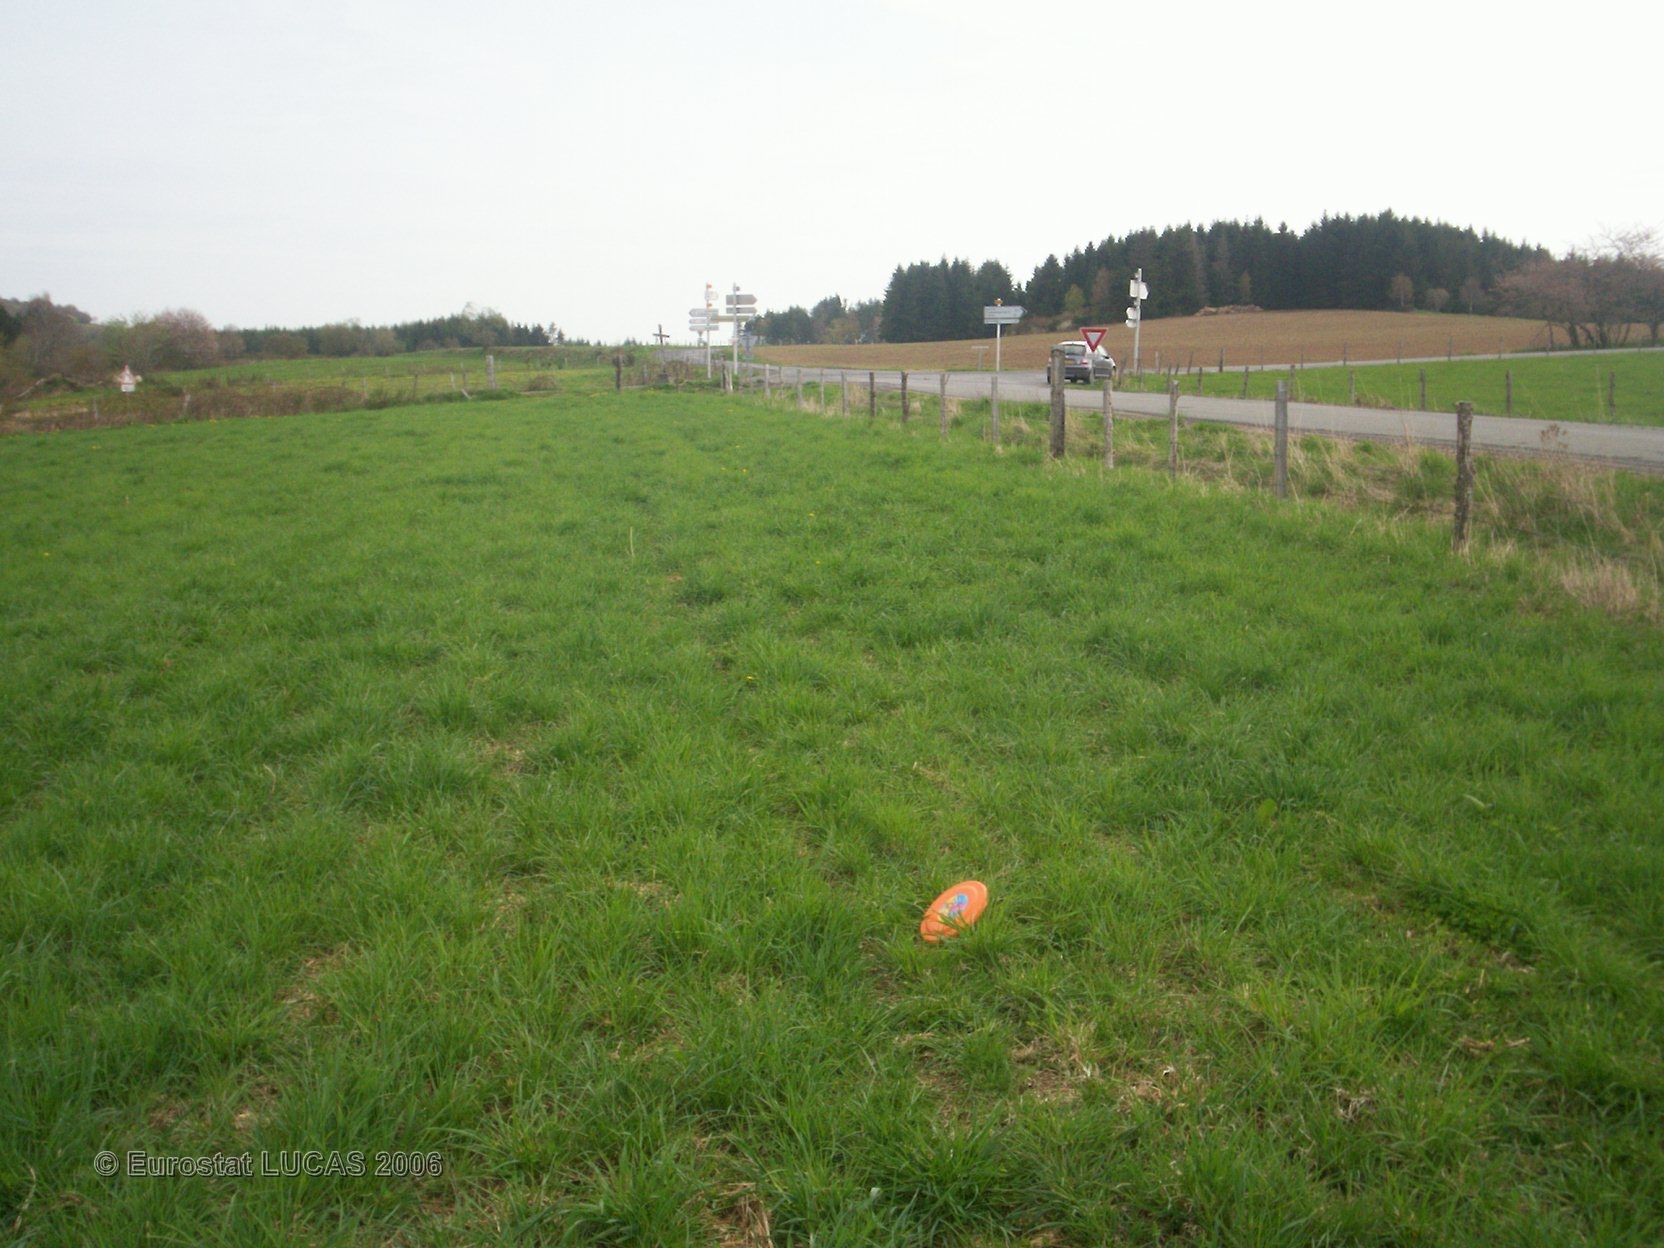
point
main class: Grassland
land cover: Grassland without tree/shrub cover
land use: Agriculture (excluding fallow land and kitchen gardens)
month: May
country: FR
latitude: 45.8997
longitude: 2.9226
